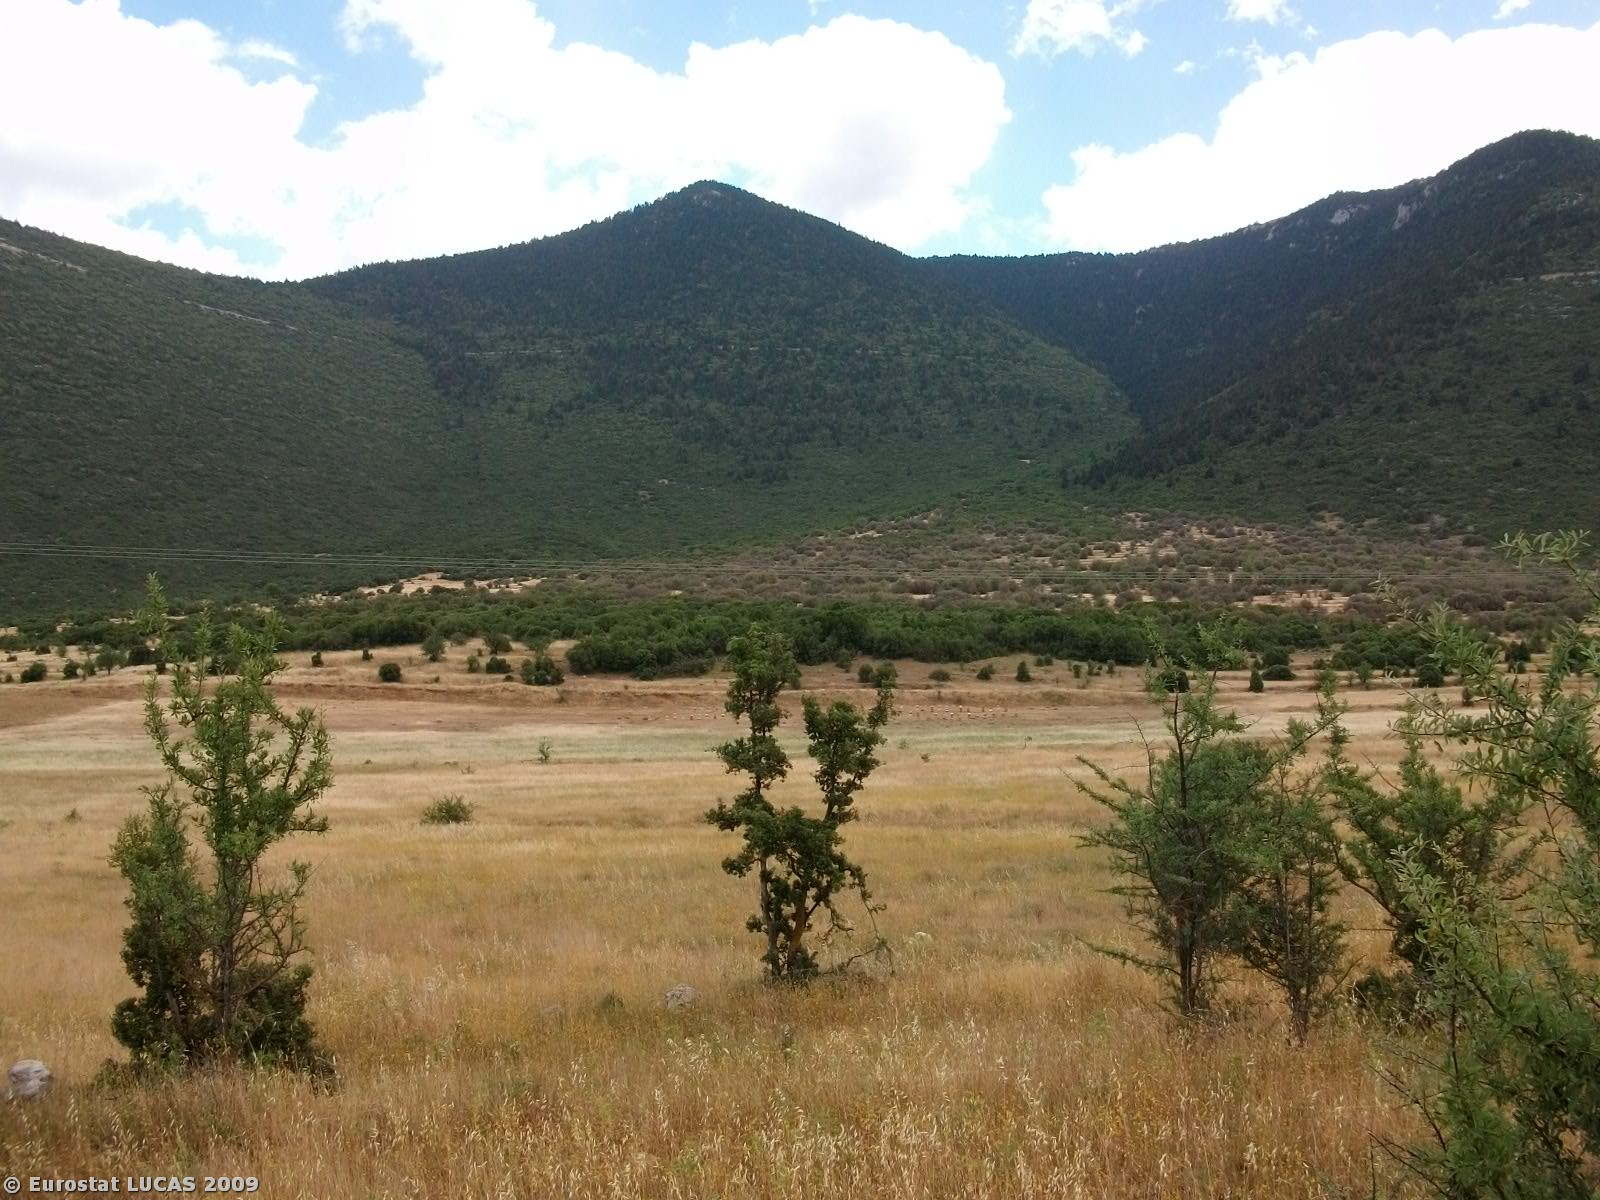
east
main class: Grassland
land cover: Grassland with sparse tree/shrub cover
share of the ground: > 75 %
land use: Unused
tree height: < 5 m
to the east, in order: Grassland with sparse tree/shrub cover; Grass margins; Grassland without tree/shrub cover; Tracks; Bare land; Grassland without tree/shrub cover; Grass margins; Tracks; Grass margins; Shrubland without tree cover
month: June
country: GR
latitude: 37.7848
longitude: 22.4680
